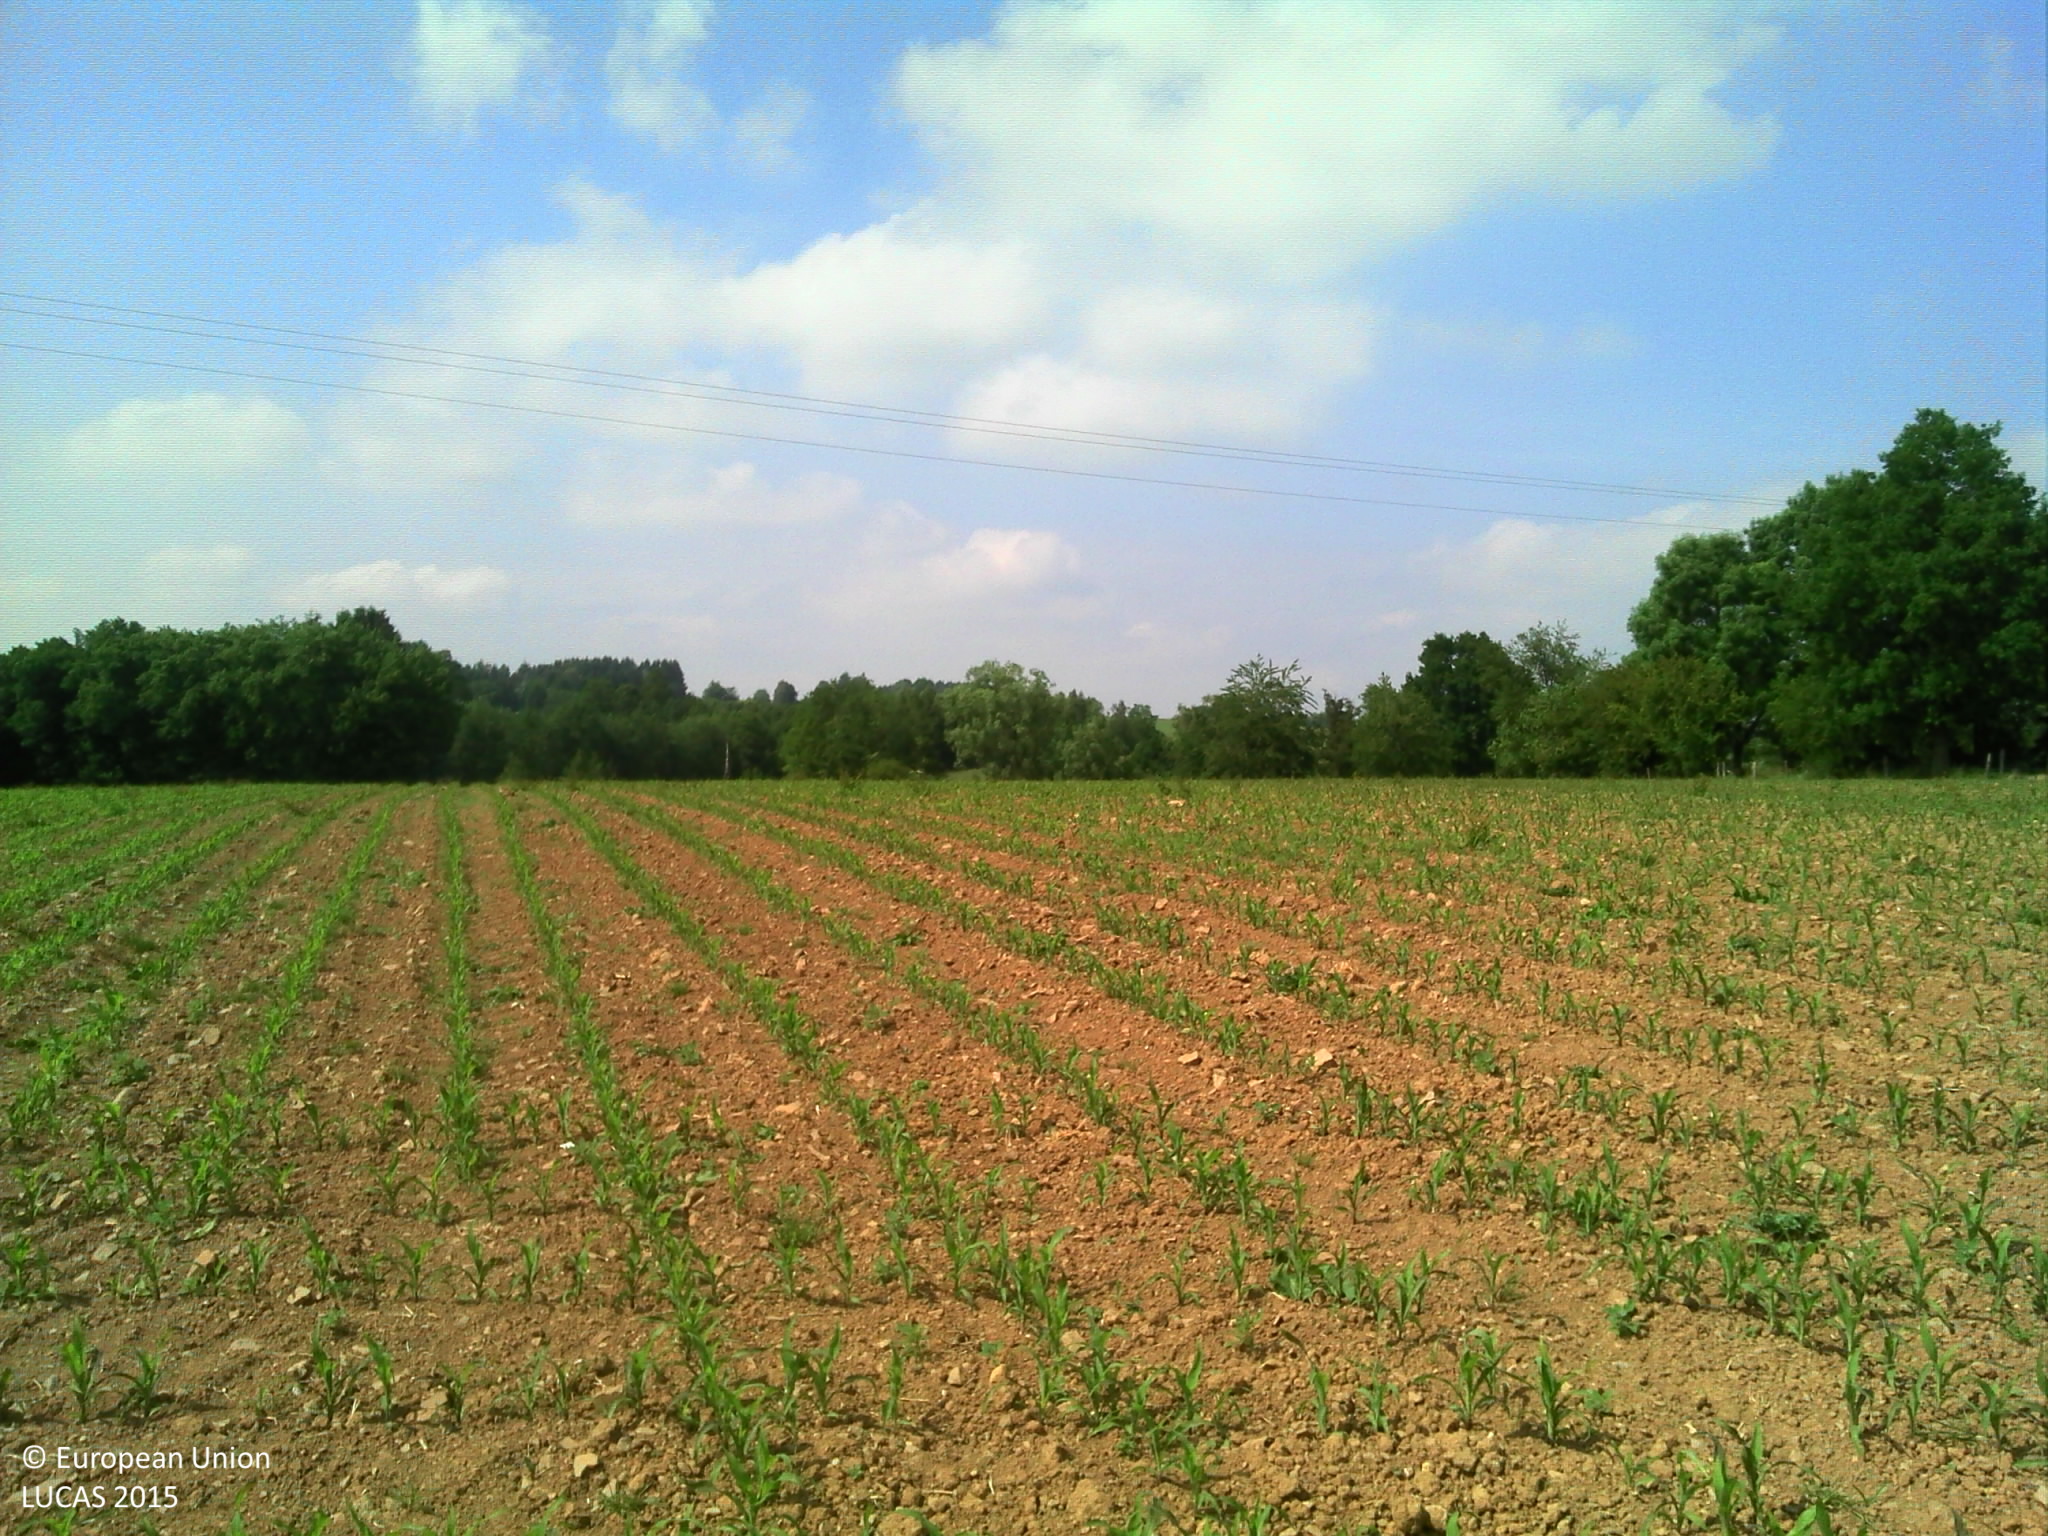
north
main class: Cropland
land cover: Maize
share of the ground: < 10 %
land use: Agriculture (excluding fallow land and kitchen gardens)
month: June
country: BE
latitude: 50.2416
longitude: 5.5535
